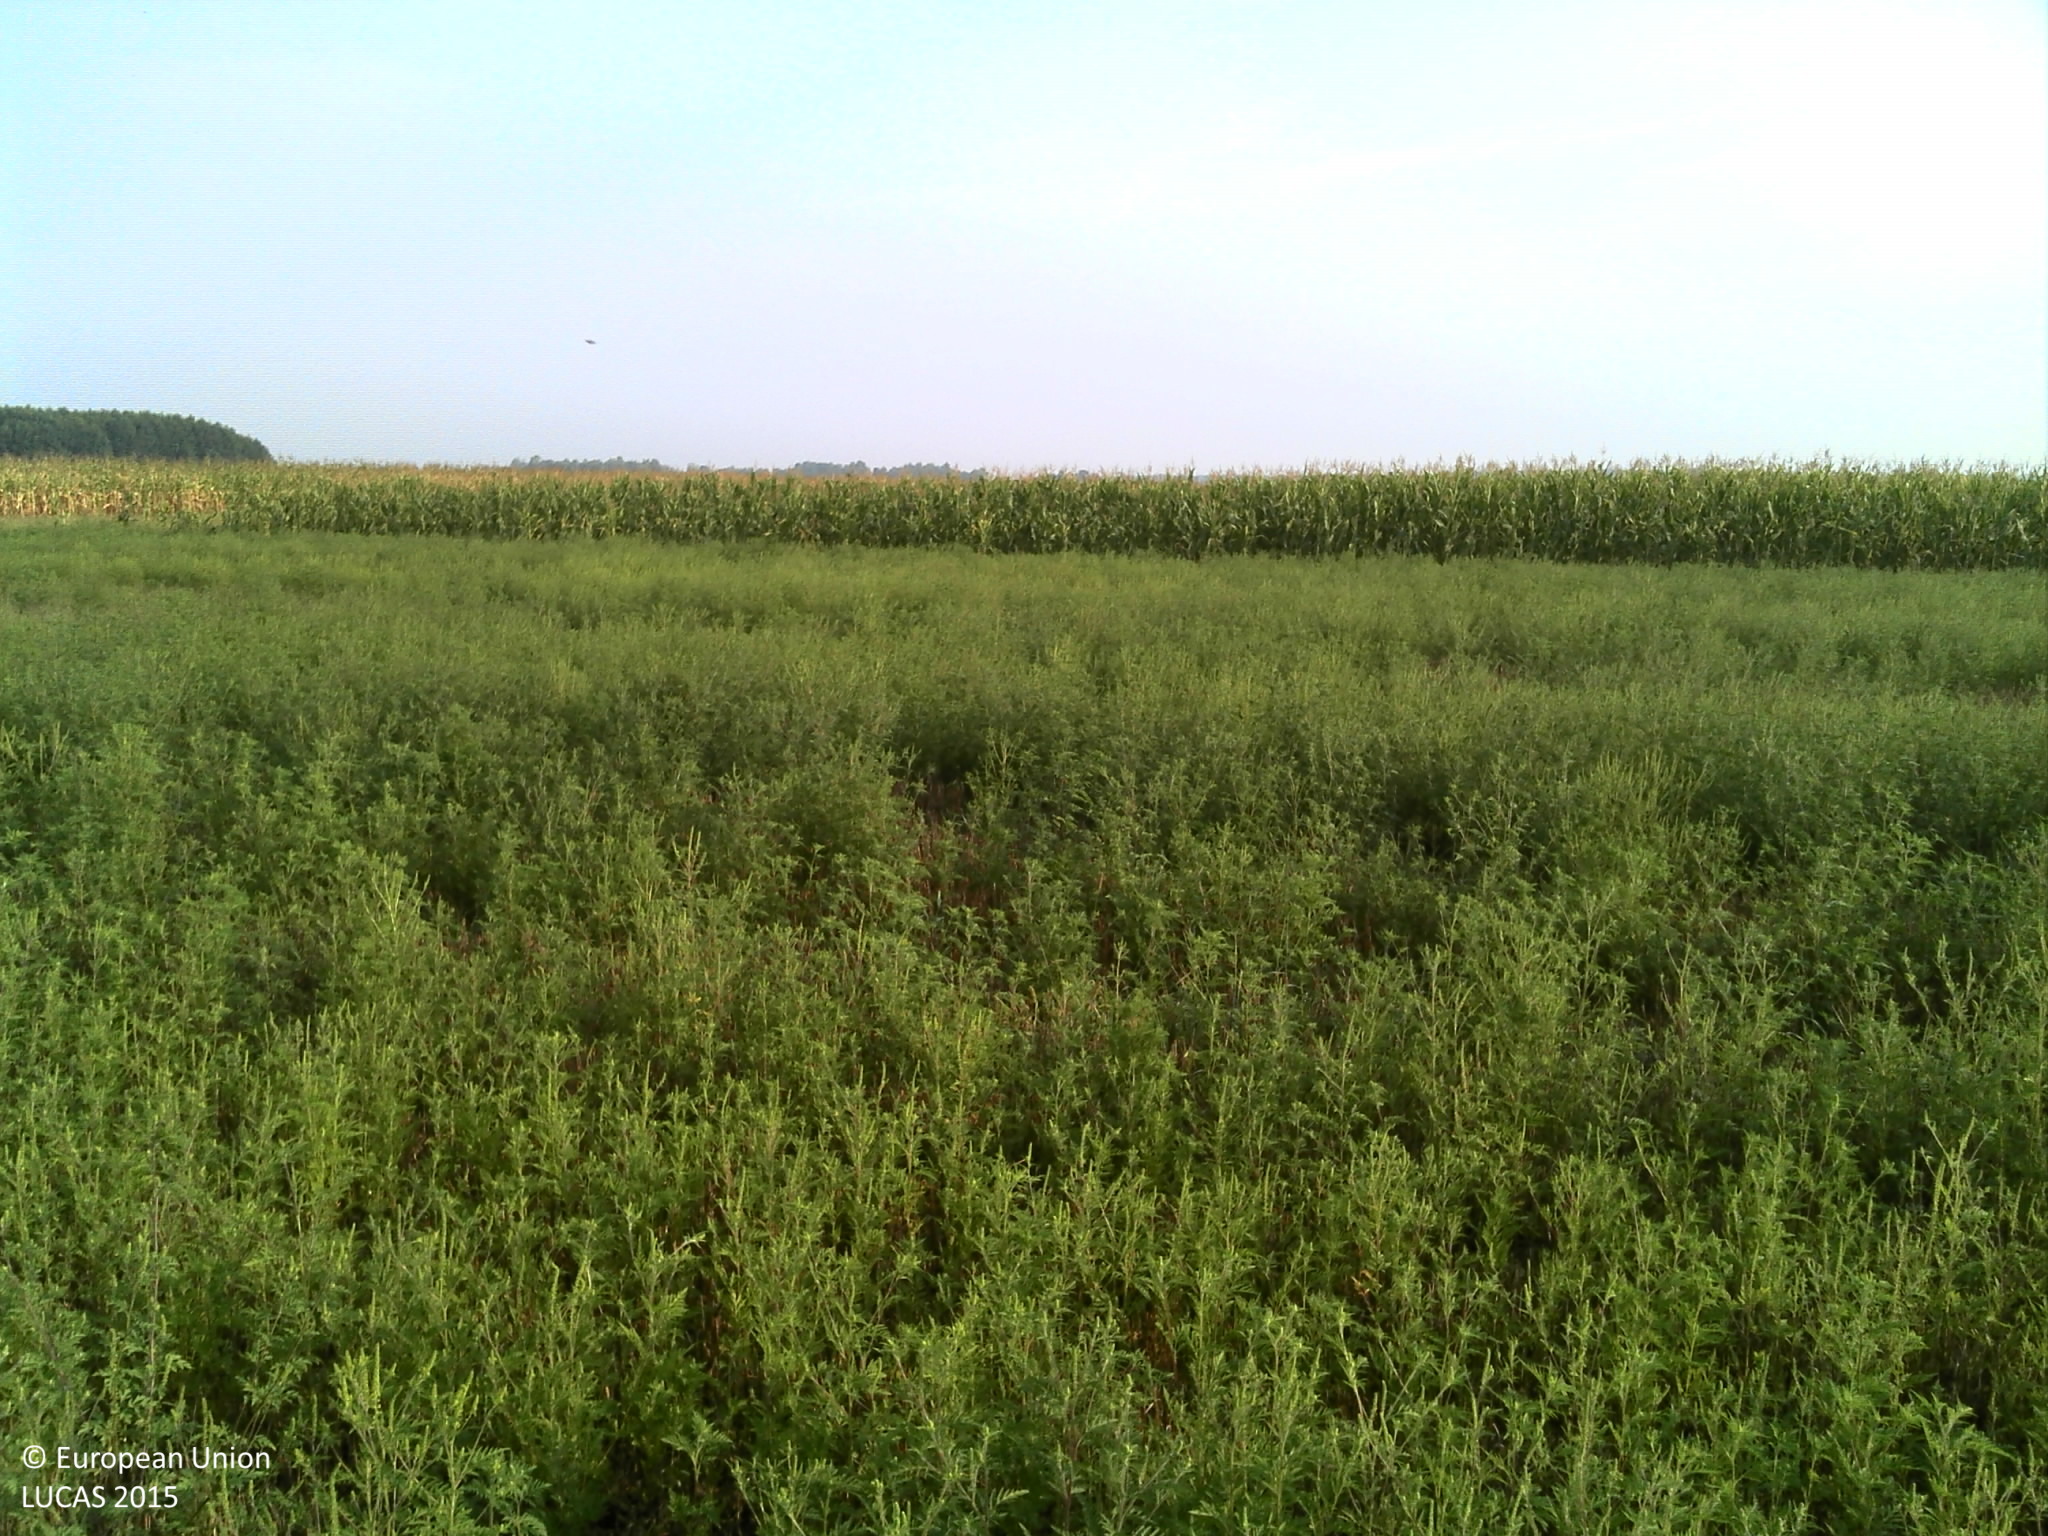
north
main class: Cropland
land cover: Common wheat
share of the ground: 10 - 25 %
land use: Agriculture (excluding fallow land and kitchen gardens)
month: August
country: HR
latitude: 45.9806
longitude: 17.2176
